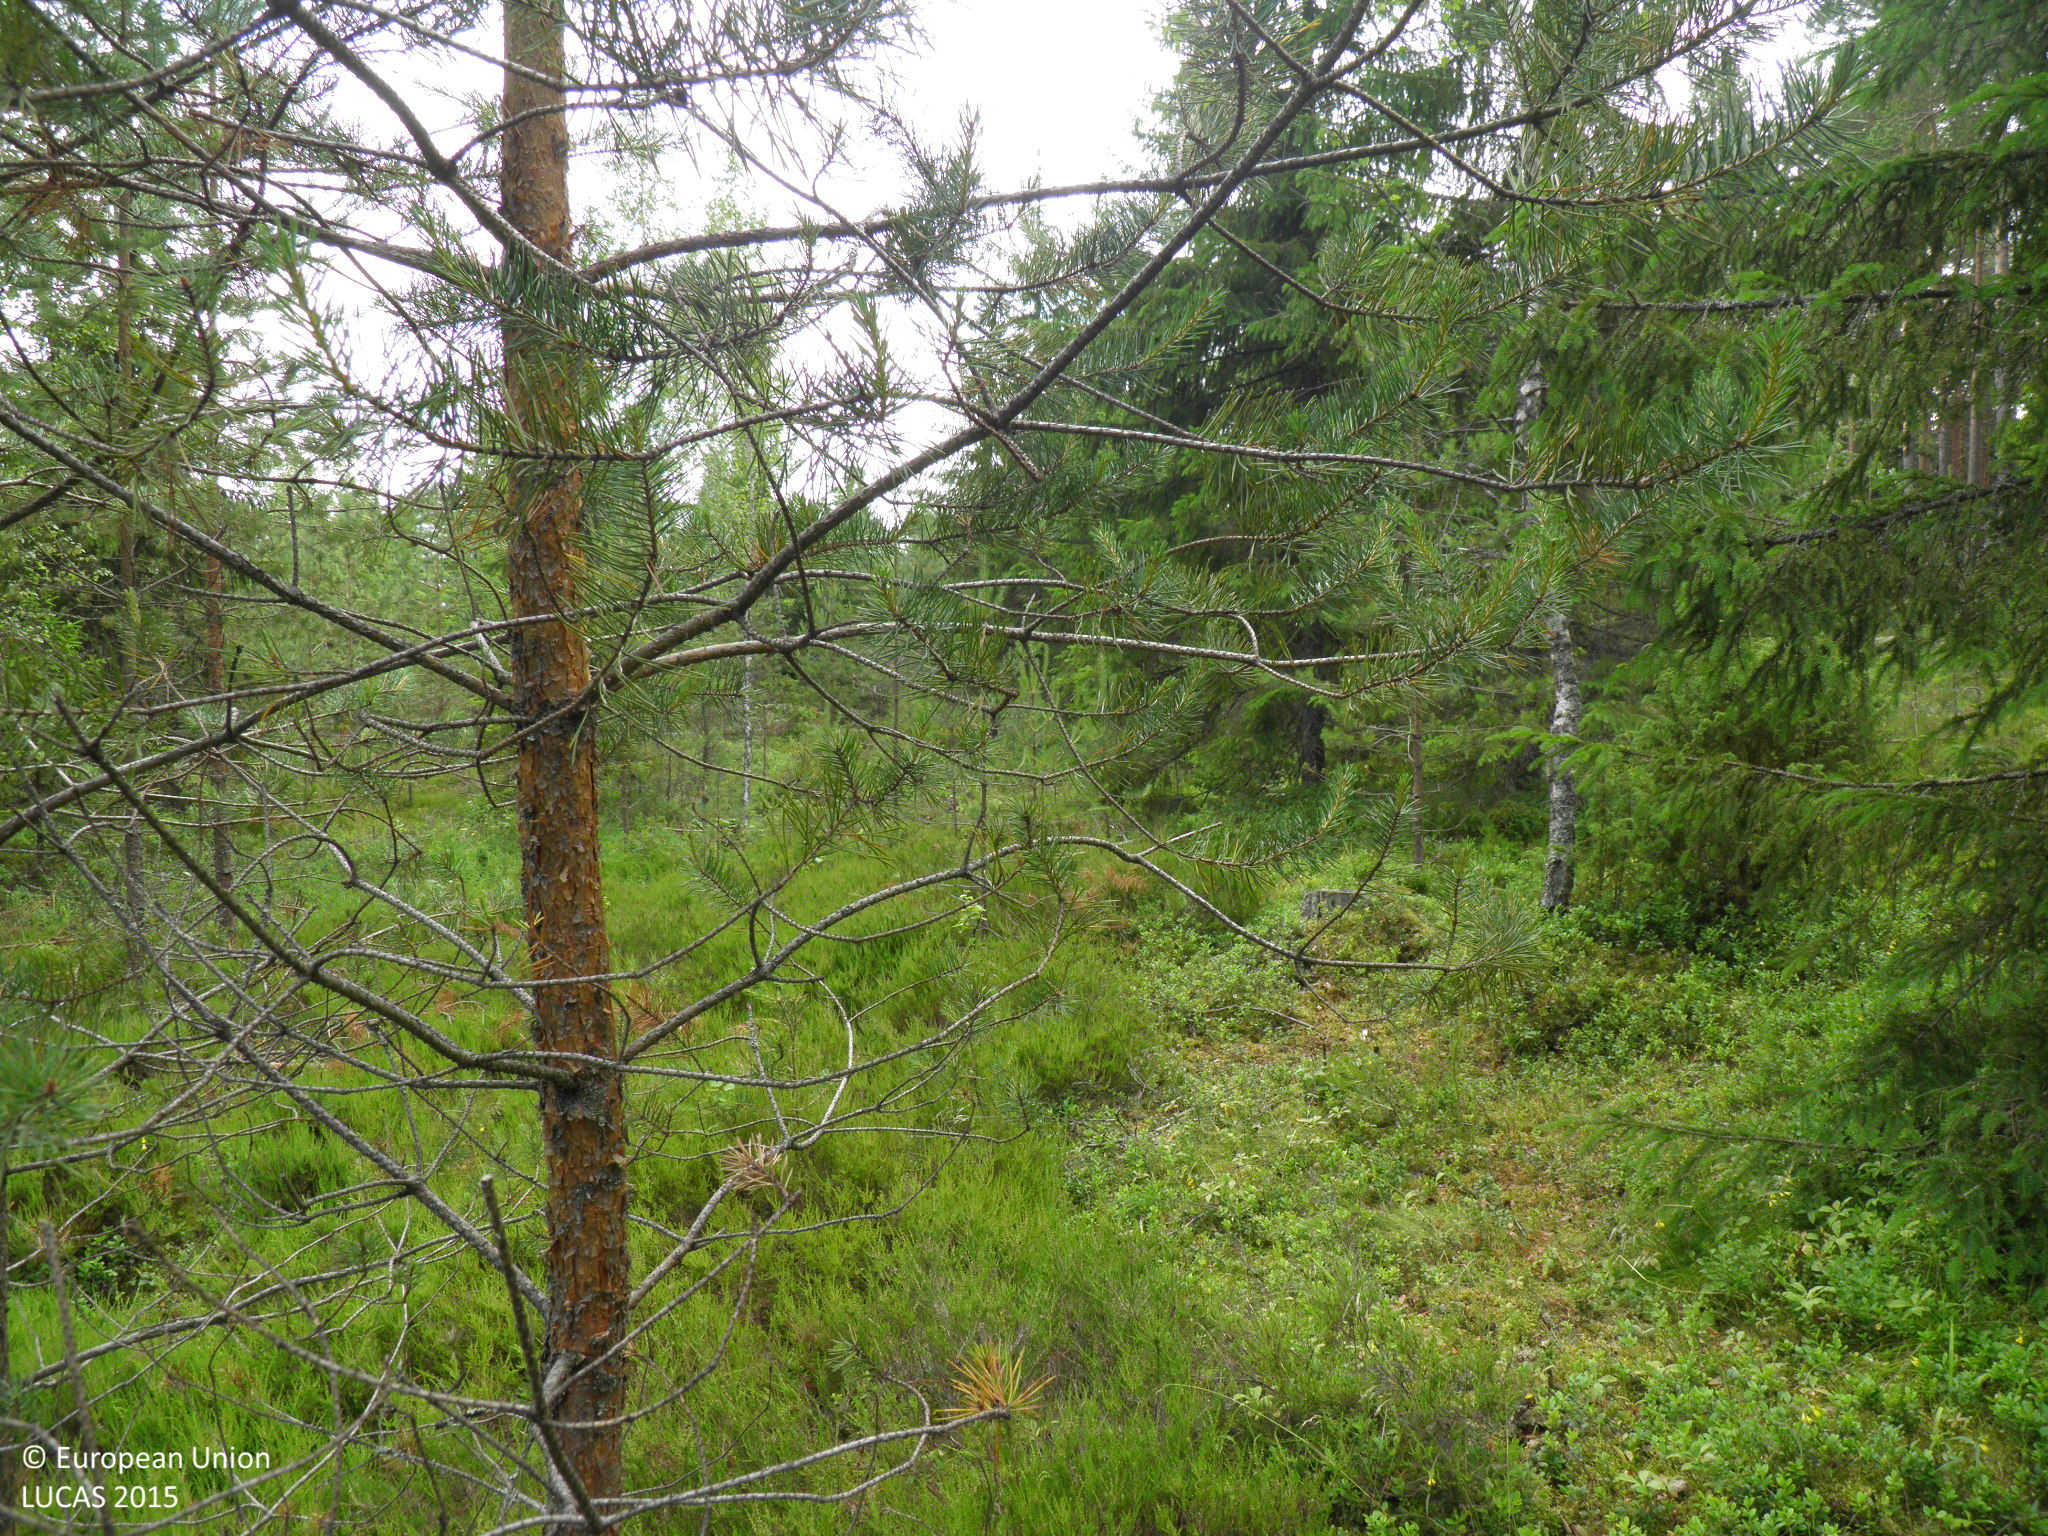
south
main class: Woodland
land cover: Other mixed woodland
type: hemiboreal forest and nemoral coniferous forest and mixed broadleaved-coniferous forest
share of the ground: 50 - 75 %
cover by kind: shrubs 50 %, coniferous forest trees 25 %, broadleaved forest trees 25 %
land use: Forestry
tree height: > 5 m
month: July
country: FI
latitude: 60.7327
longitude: 22.7433
